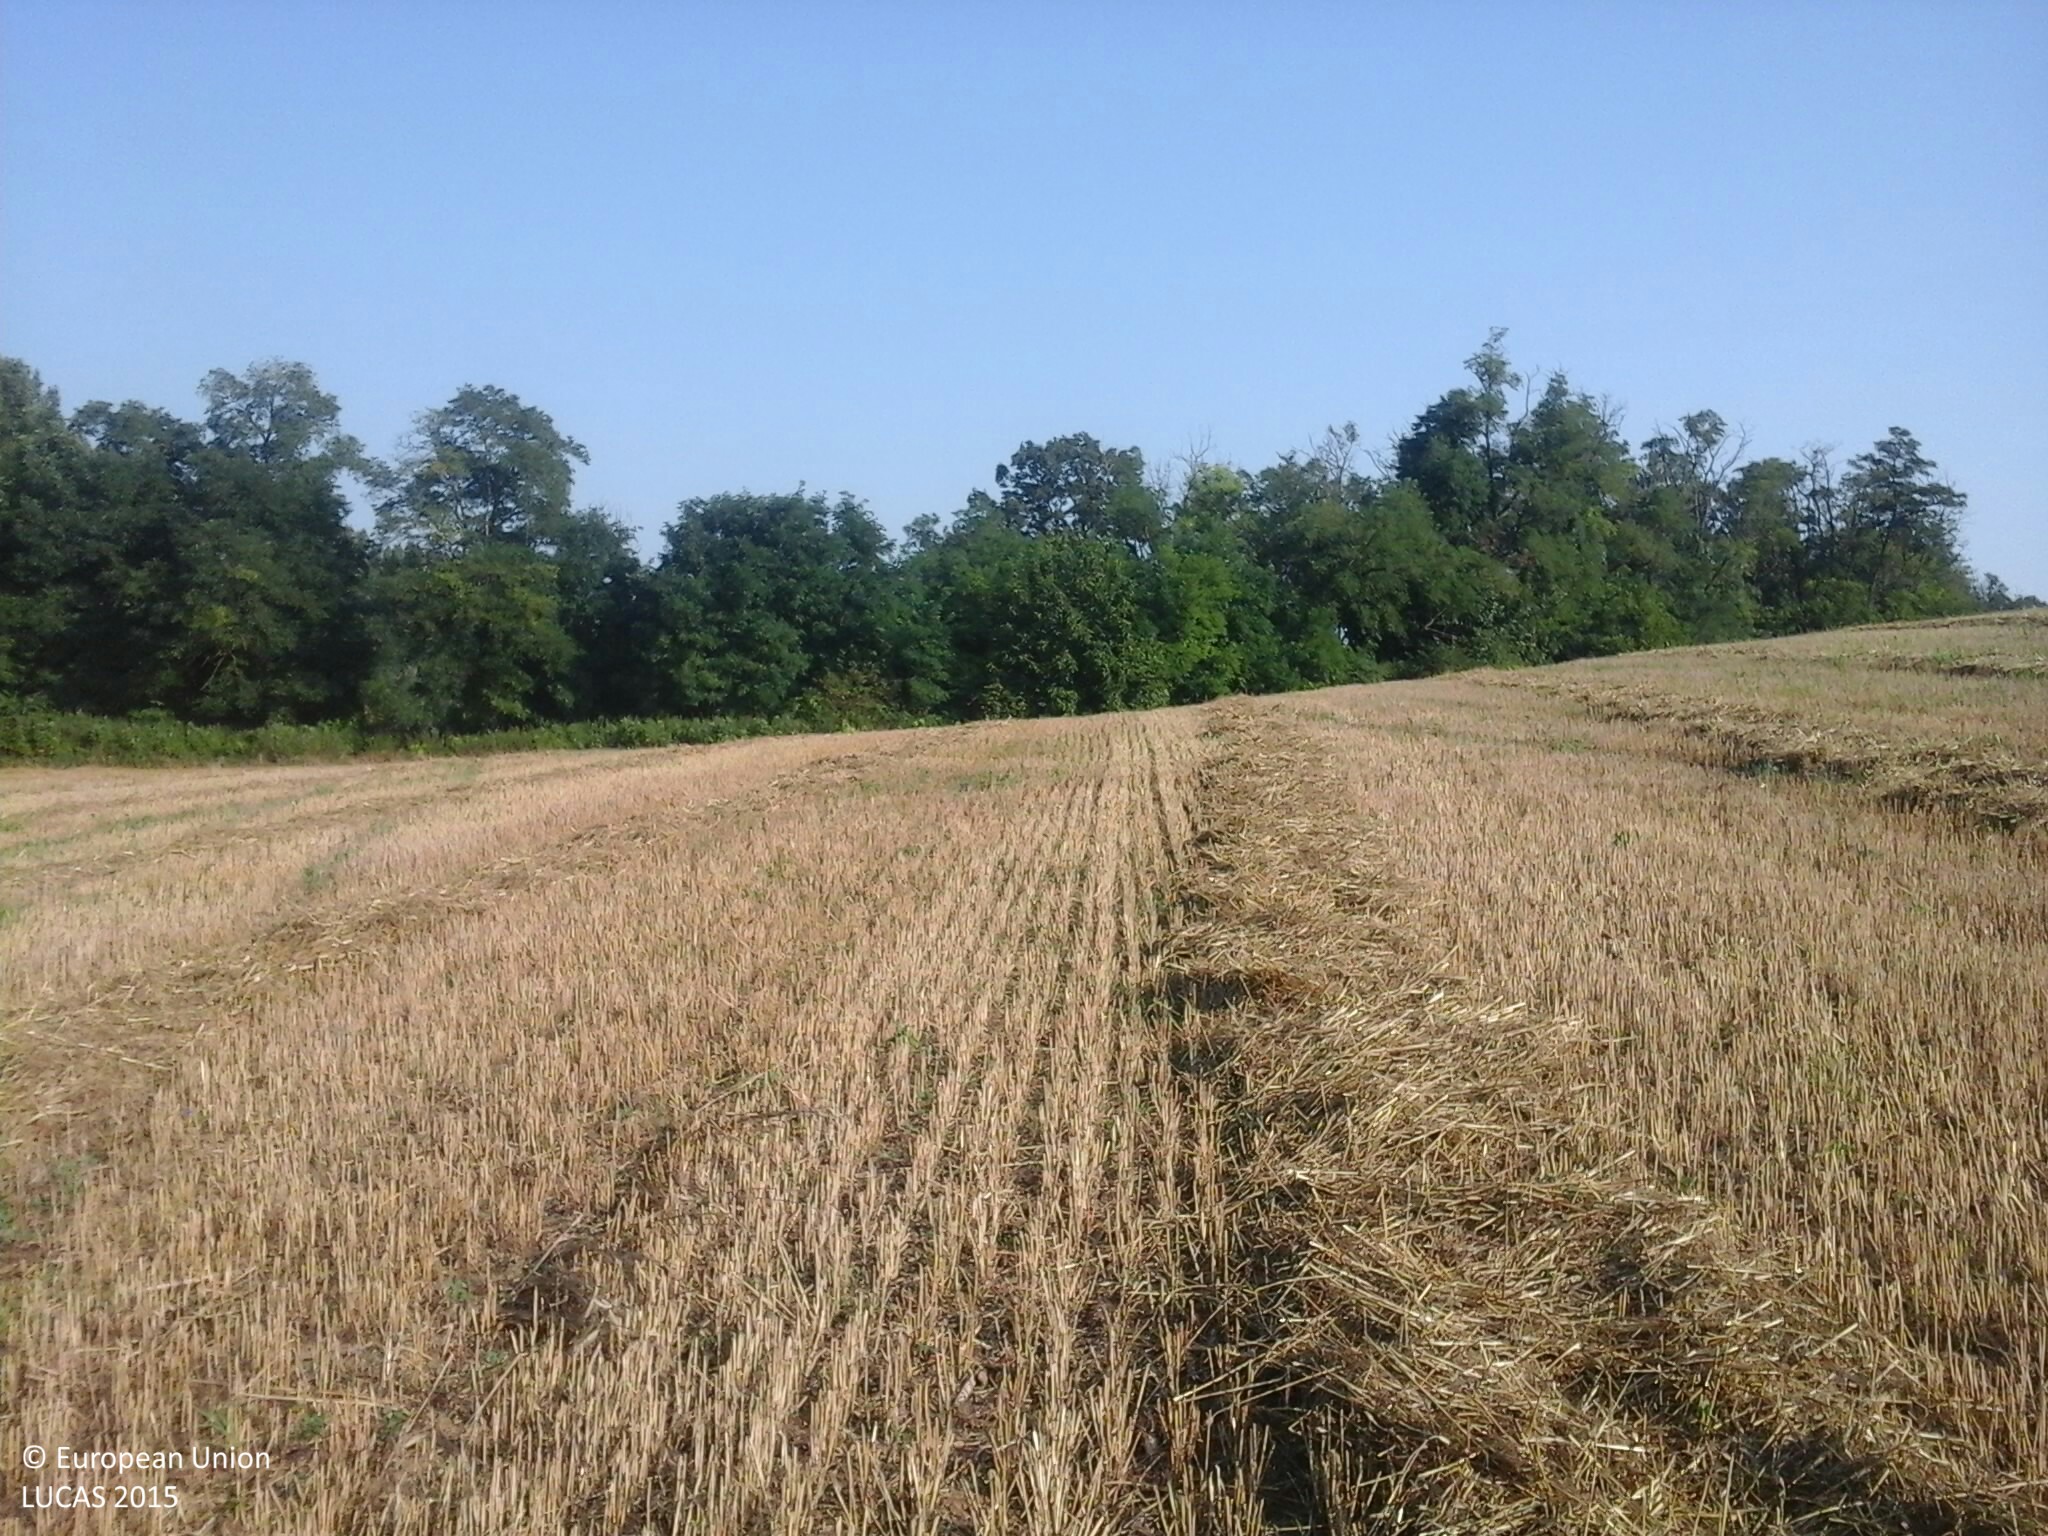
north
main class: Cropland
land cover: Durum wheat
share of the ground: > 75 %
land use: Agriculture (excluding fallow land and kitchen gardens)
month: August
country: HU
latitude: 46.7684
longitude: 18.0883
